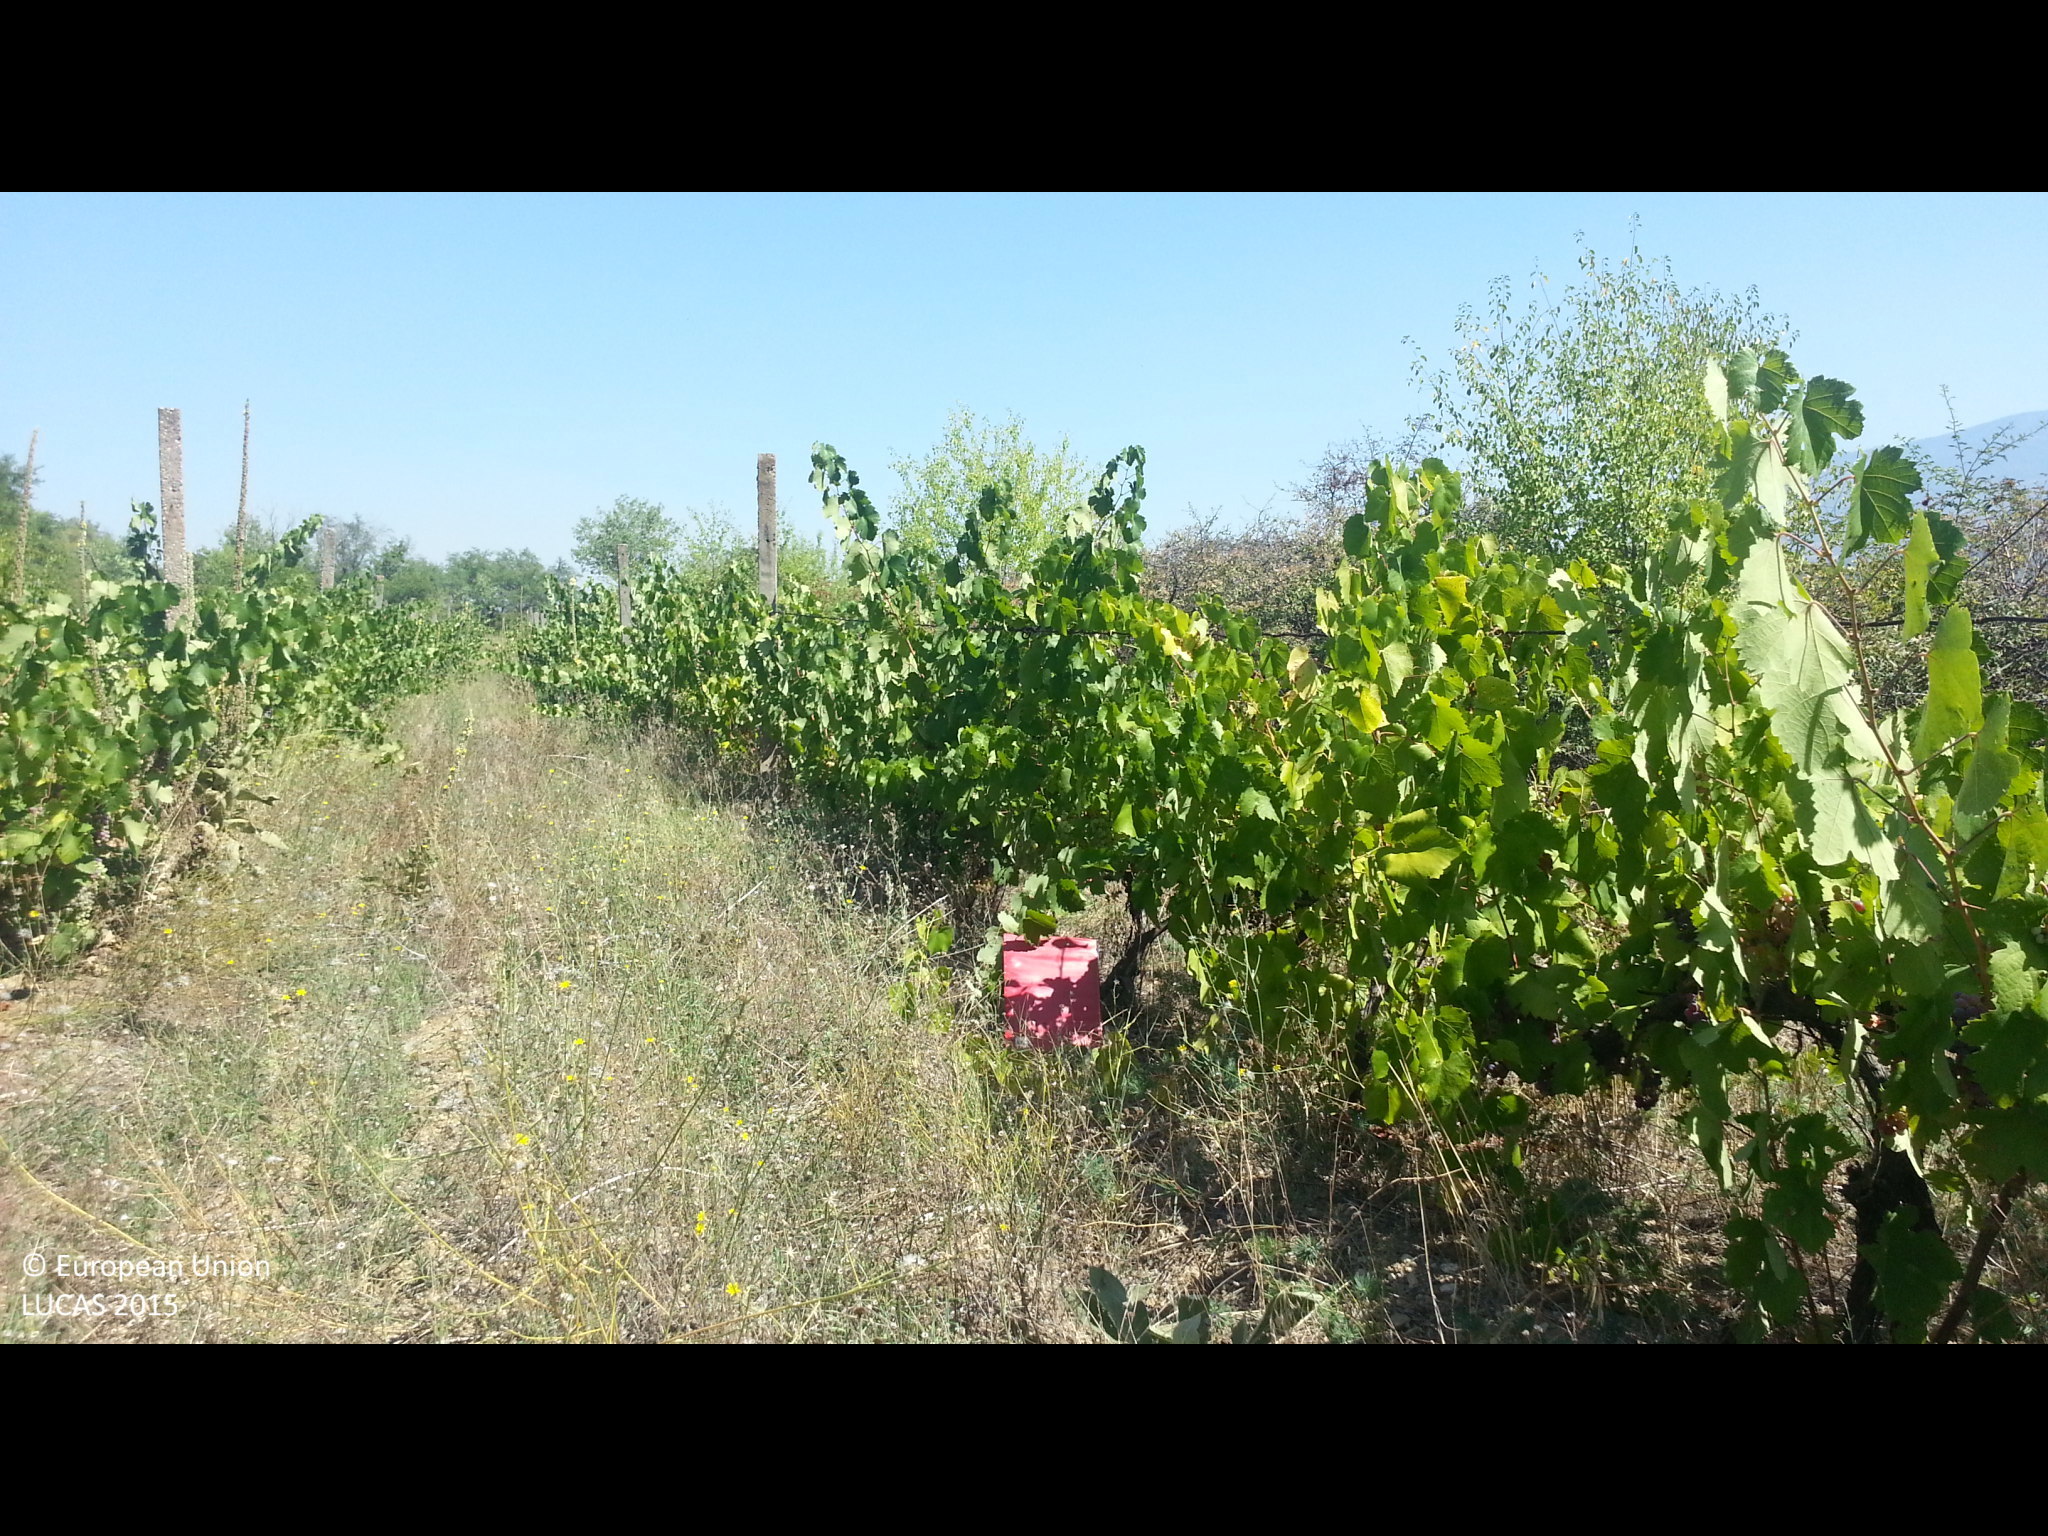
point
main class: Cropland
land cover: Vineyards
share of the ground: 25 - 50 %
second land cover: Spontaneously vegetated surfaces
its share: 50 - 75 %
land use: Agriculture (excluding fallow land and kitchen gardens)
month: September
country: BG
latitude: 42.1726
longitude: 23.0386
